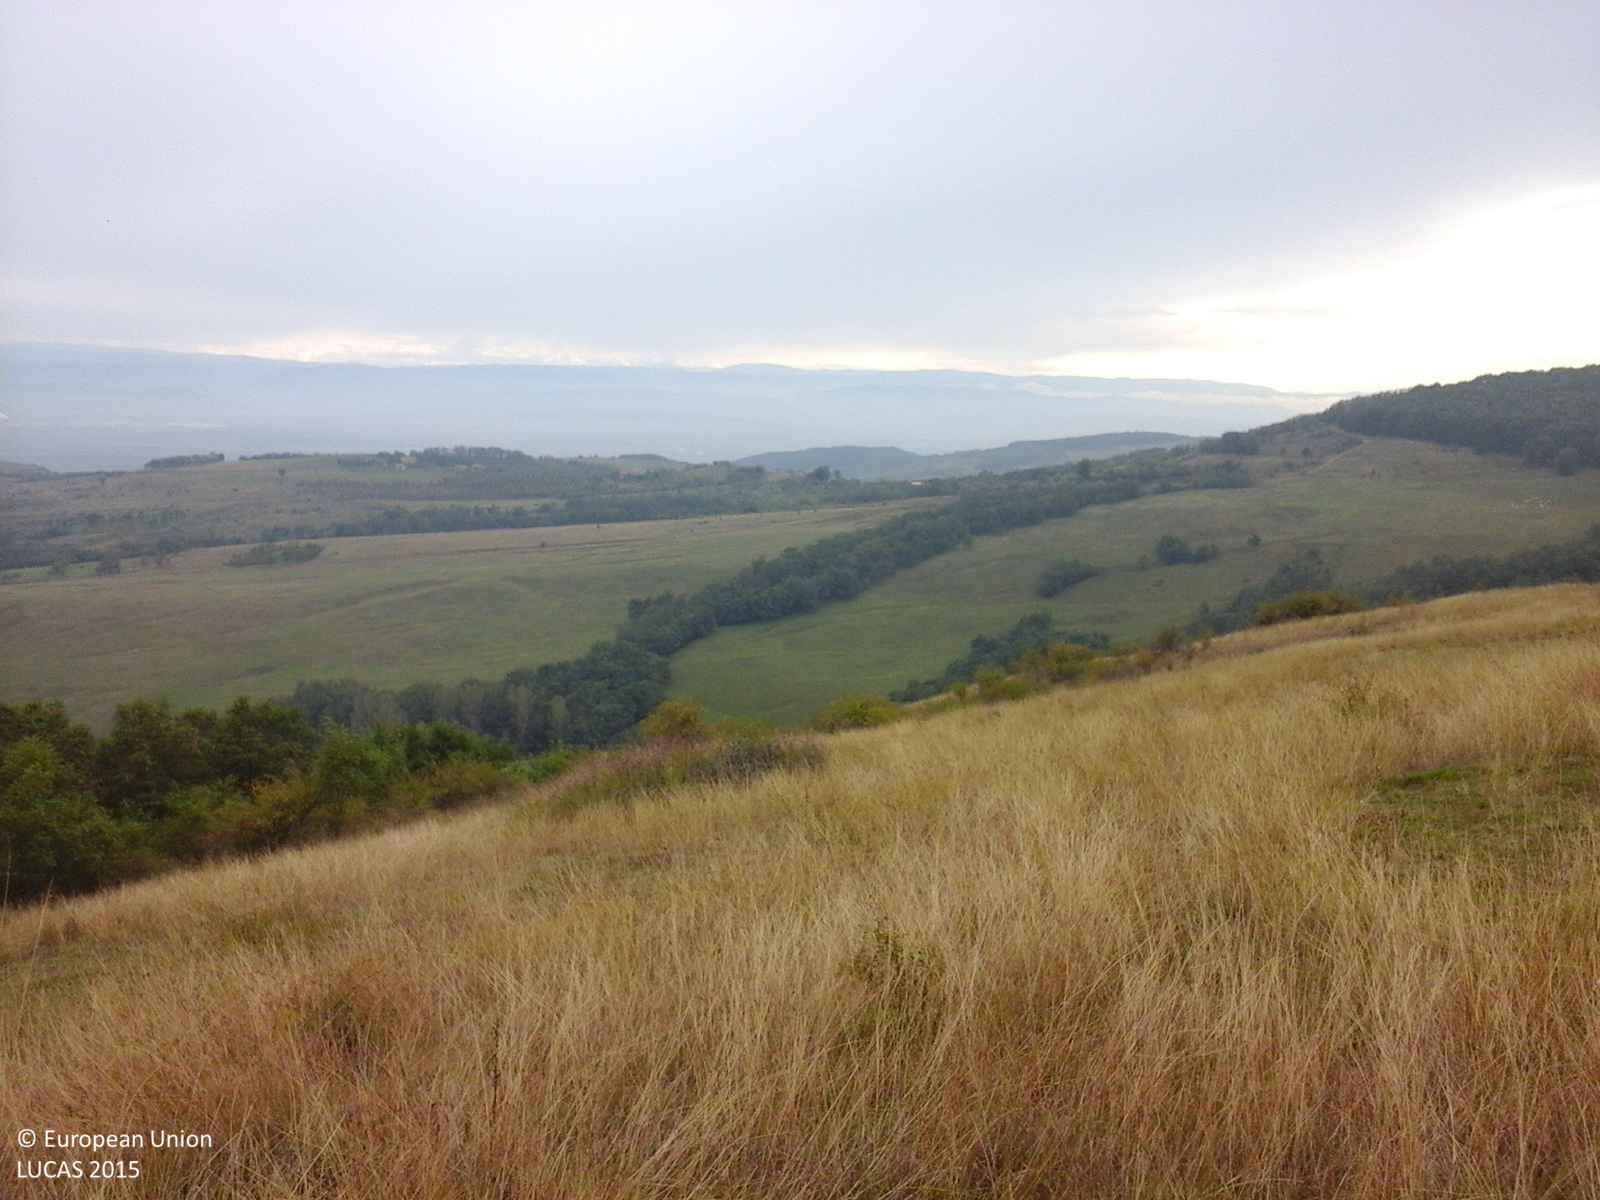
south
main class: Grassland
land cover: Grassland without tree/shrub cover
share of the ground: > 75 %
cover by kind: herbaceous plants 100 %
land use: Agriculture (excluding fallow land and kitchen gardens)
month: October
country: RO
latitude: 46.0572
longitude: 23.4946
